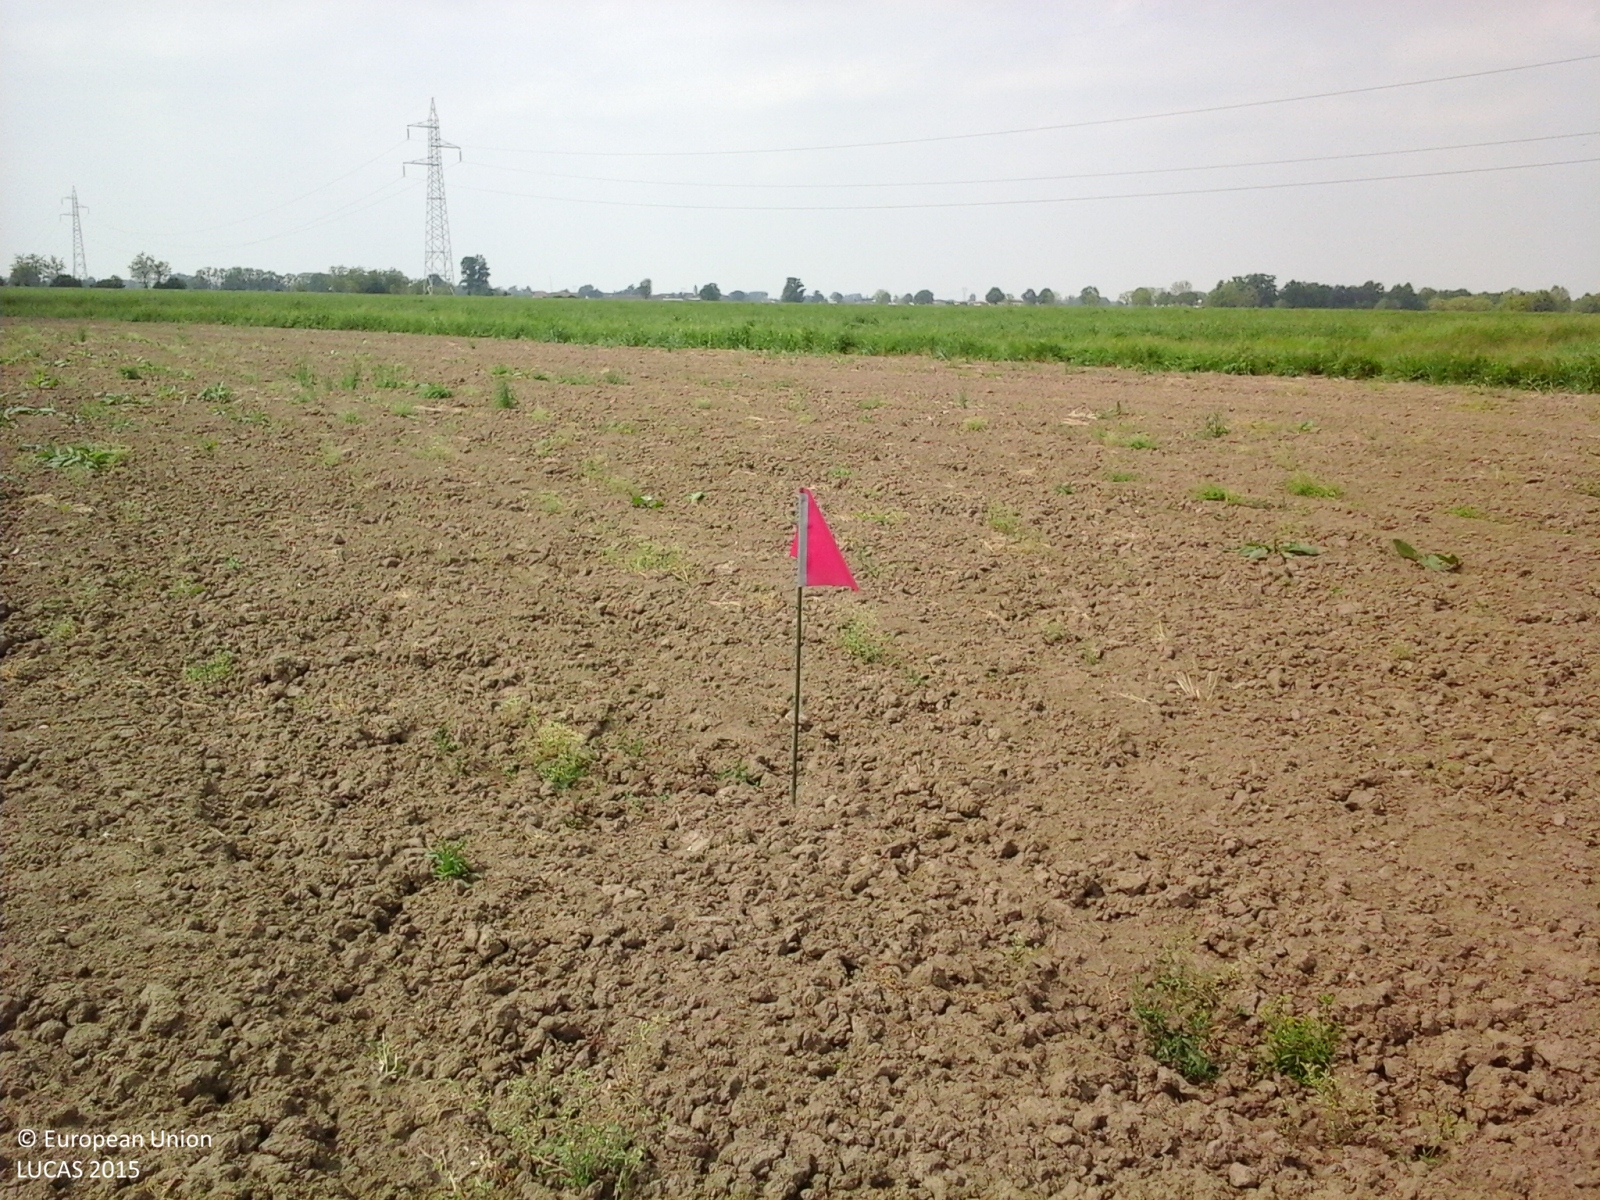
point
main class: Cropland
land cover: Maize
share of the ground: < 10 %
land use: Agriculture (excluding fallow land and kitchen gardens)
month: May
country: IT
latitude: 45.0715
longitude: 10.2662
